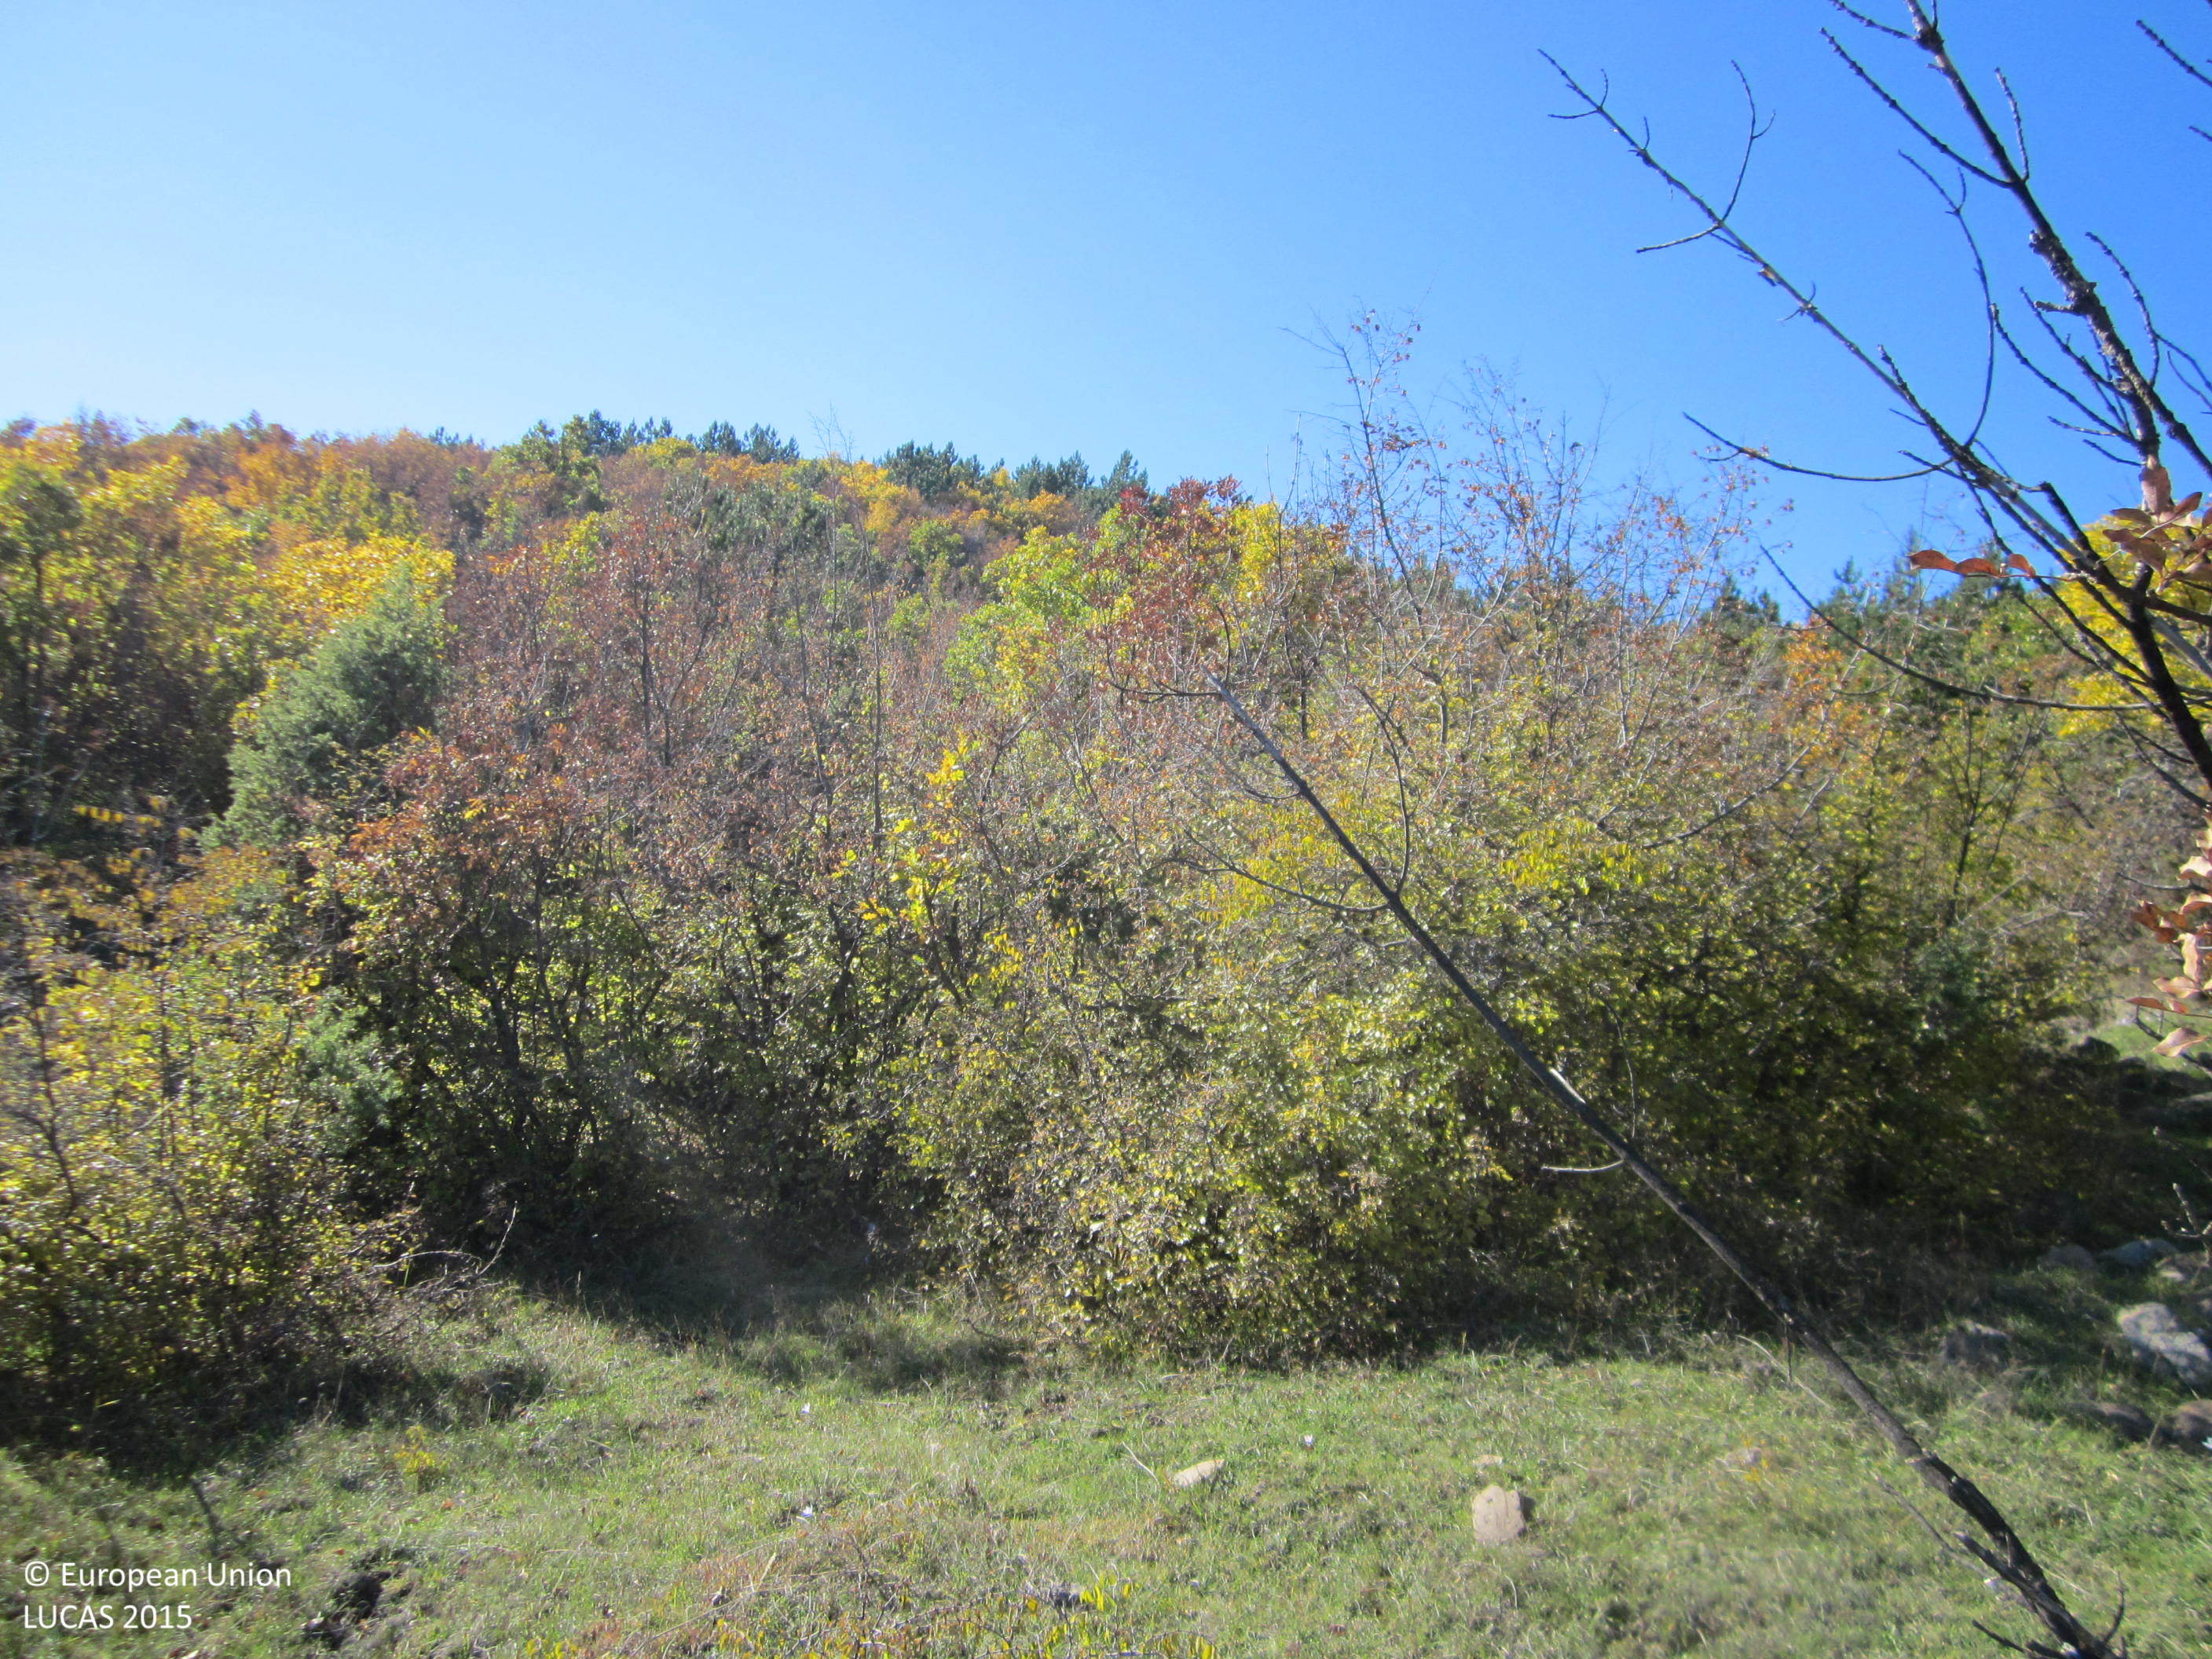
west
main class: Woodland
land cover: Broadleaved woodland
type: mesophytic deciduous forest
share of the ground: > 75 %
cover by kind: broadleaved forest trees 100 %
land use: Forestry
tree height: > 5 m
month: November
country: BG
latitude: 41.5845
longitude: 25.5941
